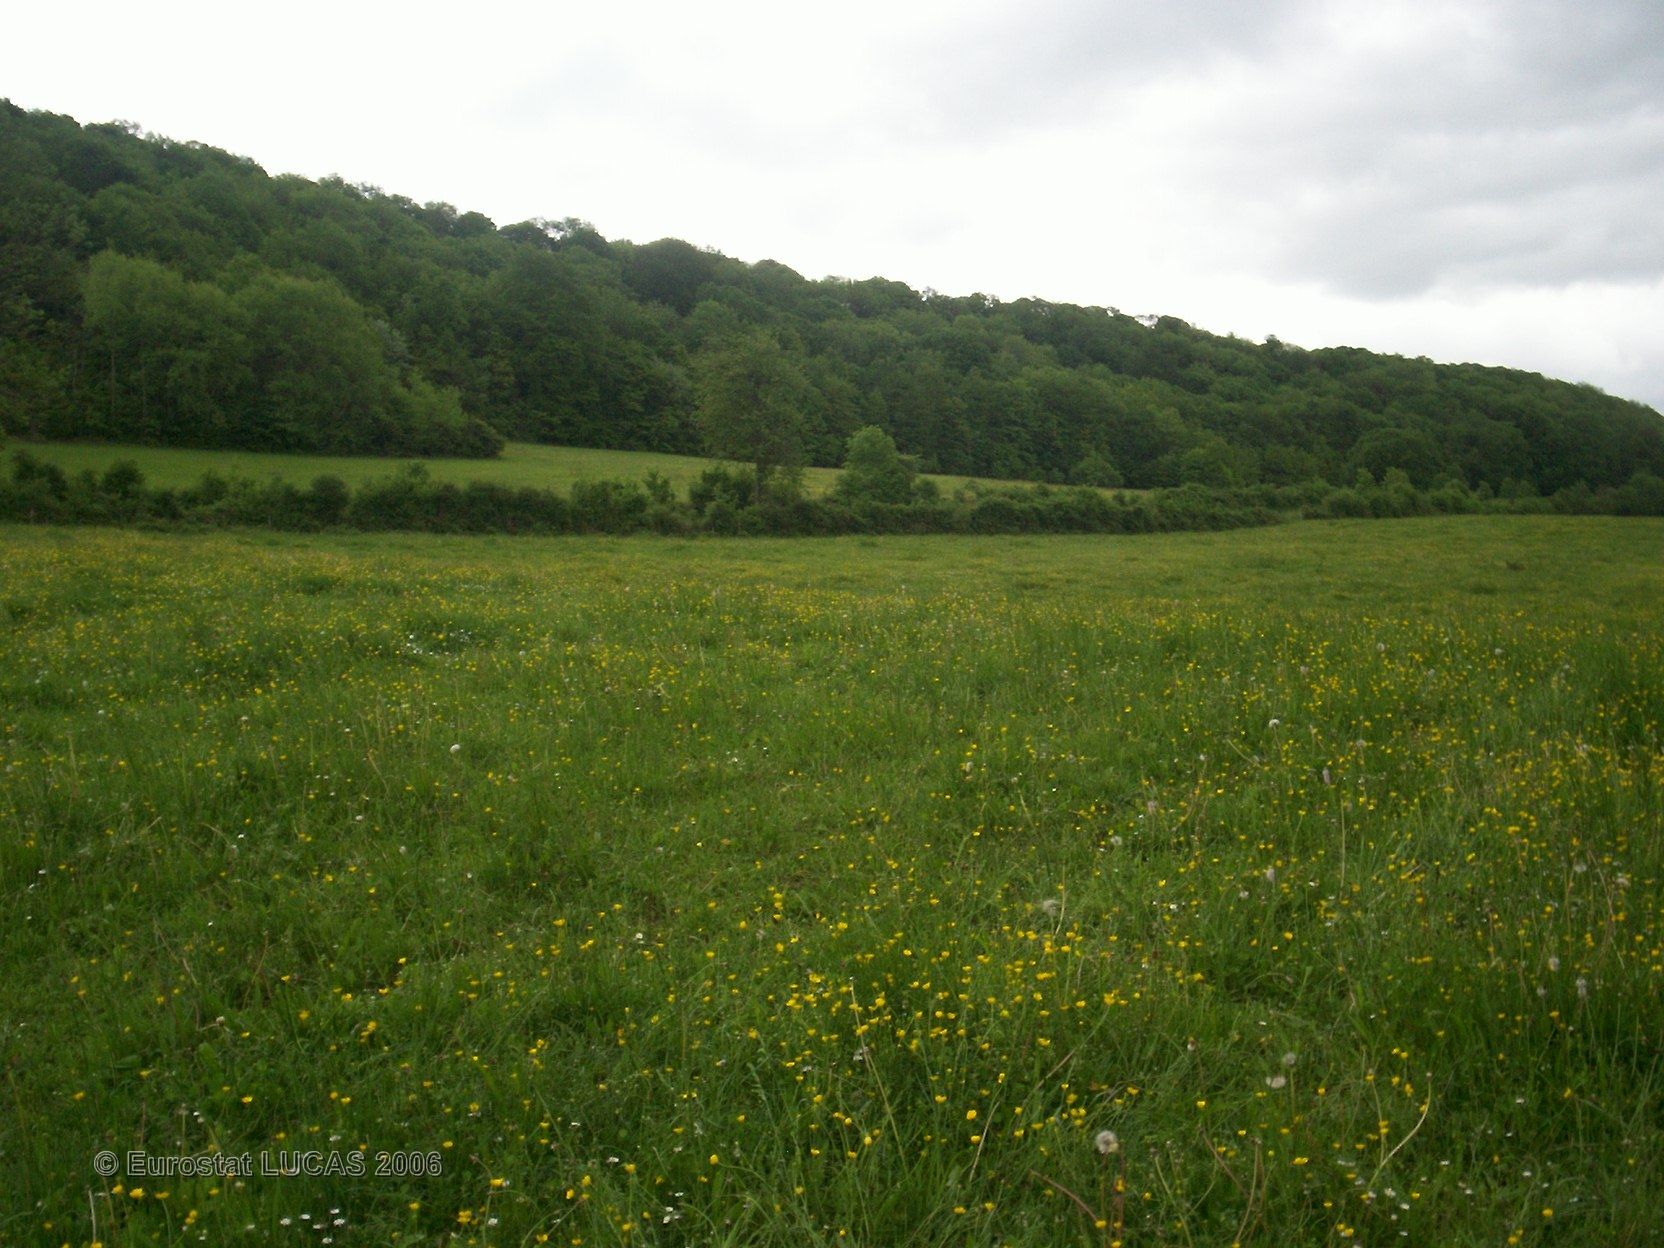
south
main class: Grassland
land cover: Grassland without tree/shrub cover
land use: Agriculture (excluding fallow land and kitchen gardens)
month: May
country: FR
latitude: 47.1741
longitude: 4.6565
